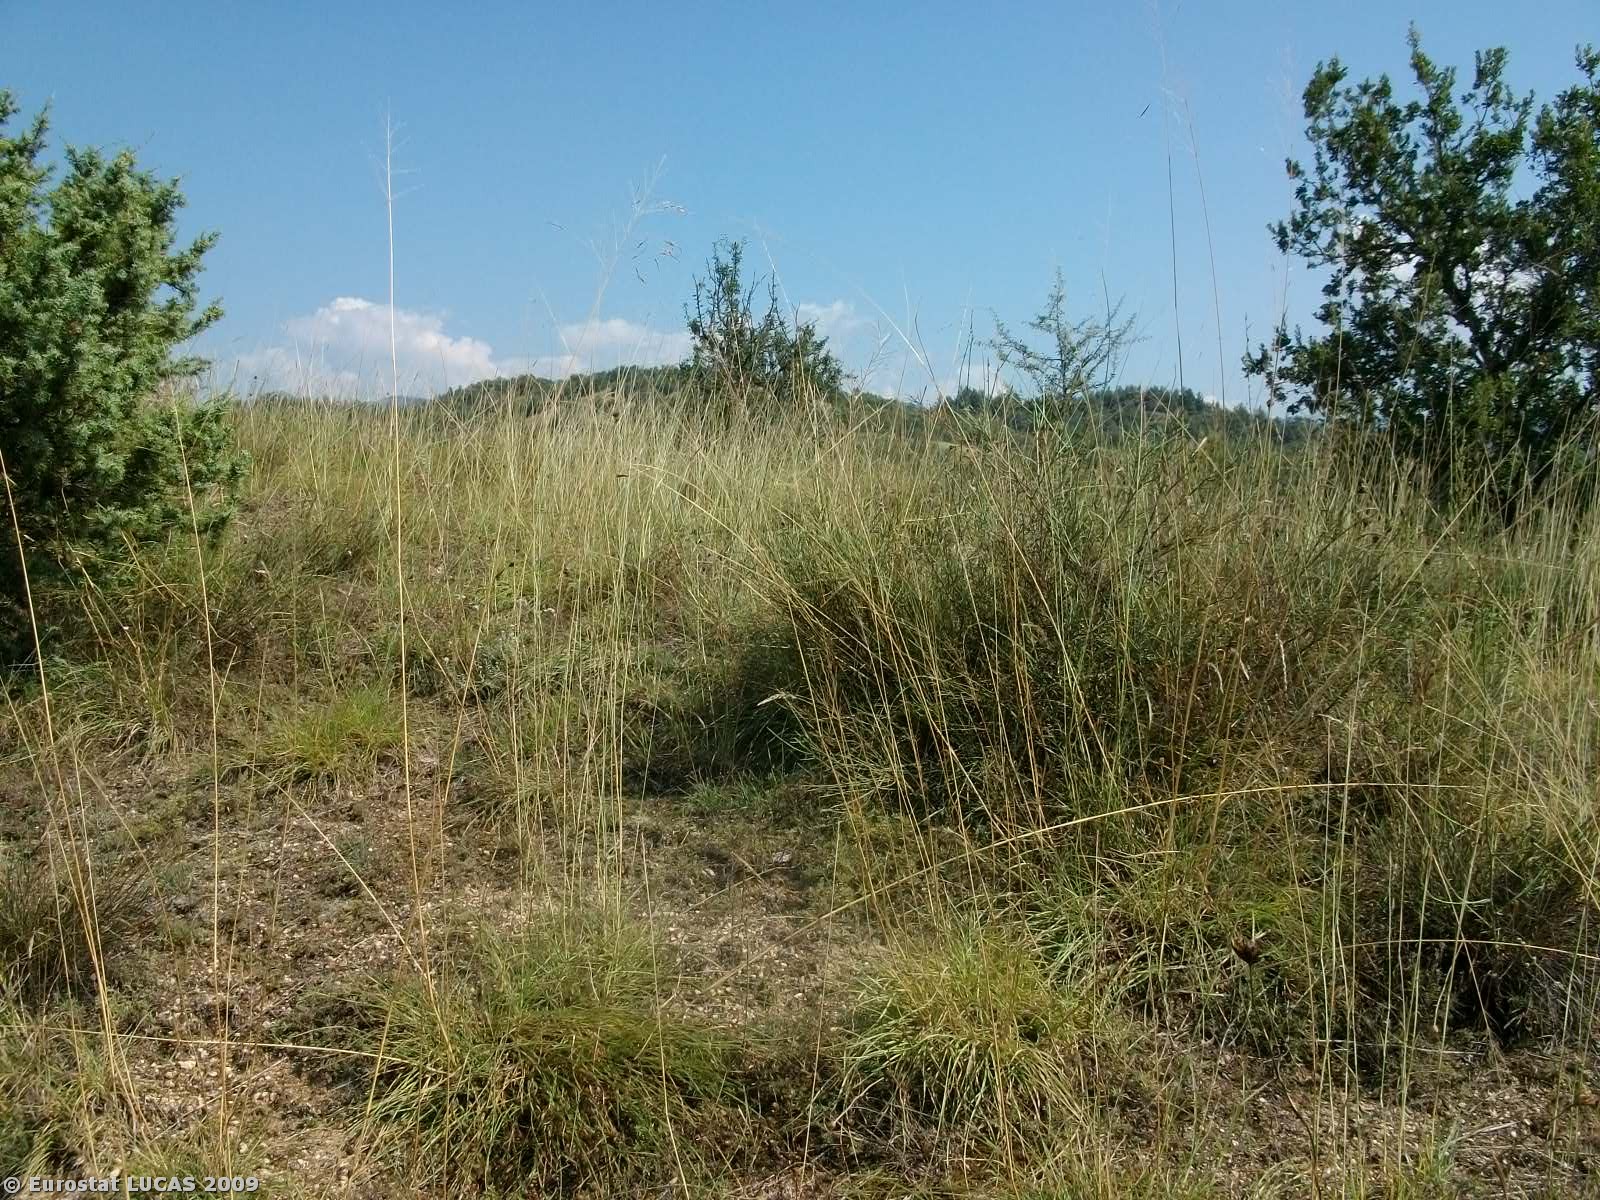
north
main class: Shrubland
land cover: Shrubland with sparse tree cover
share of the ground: > 75 %
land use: Unused
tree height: < 5 m
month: August
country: GR
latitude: 41.2754
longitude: 24.4938
